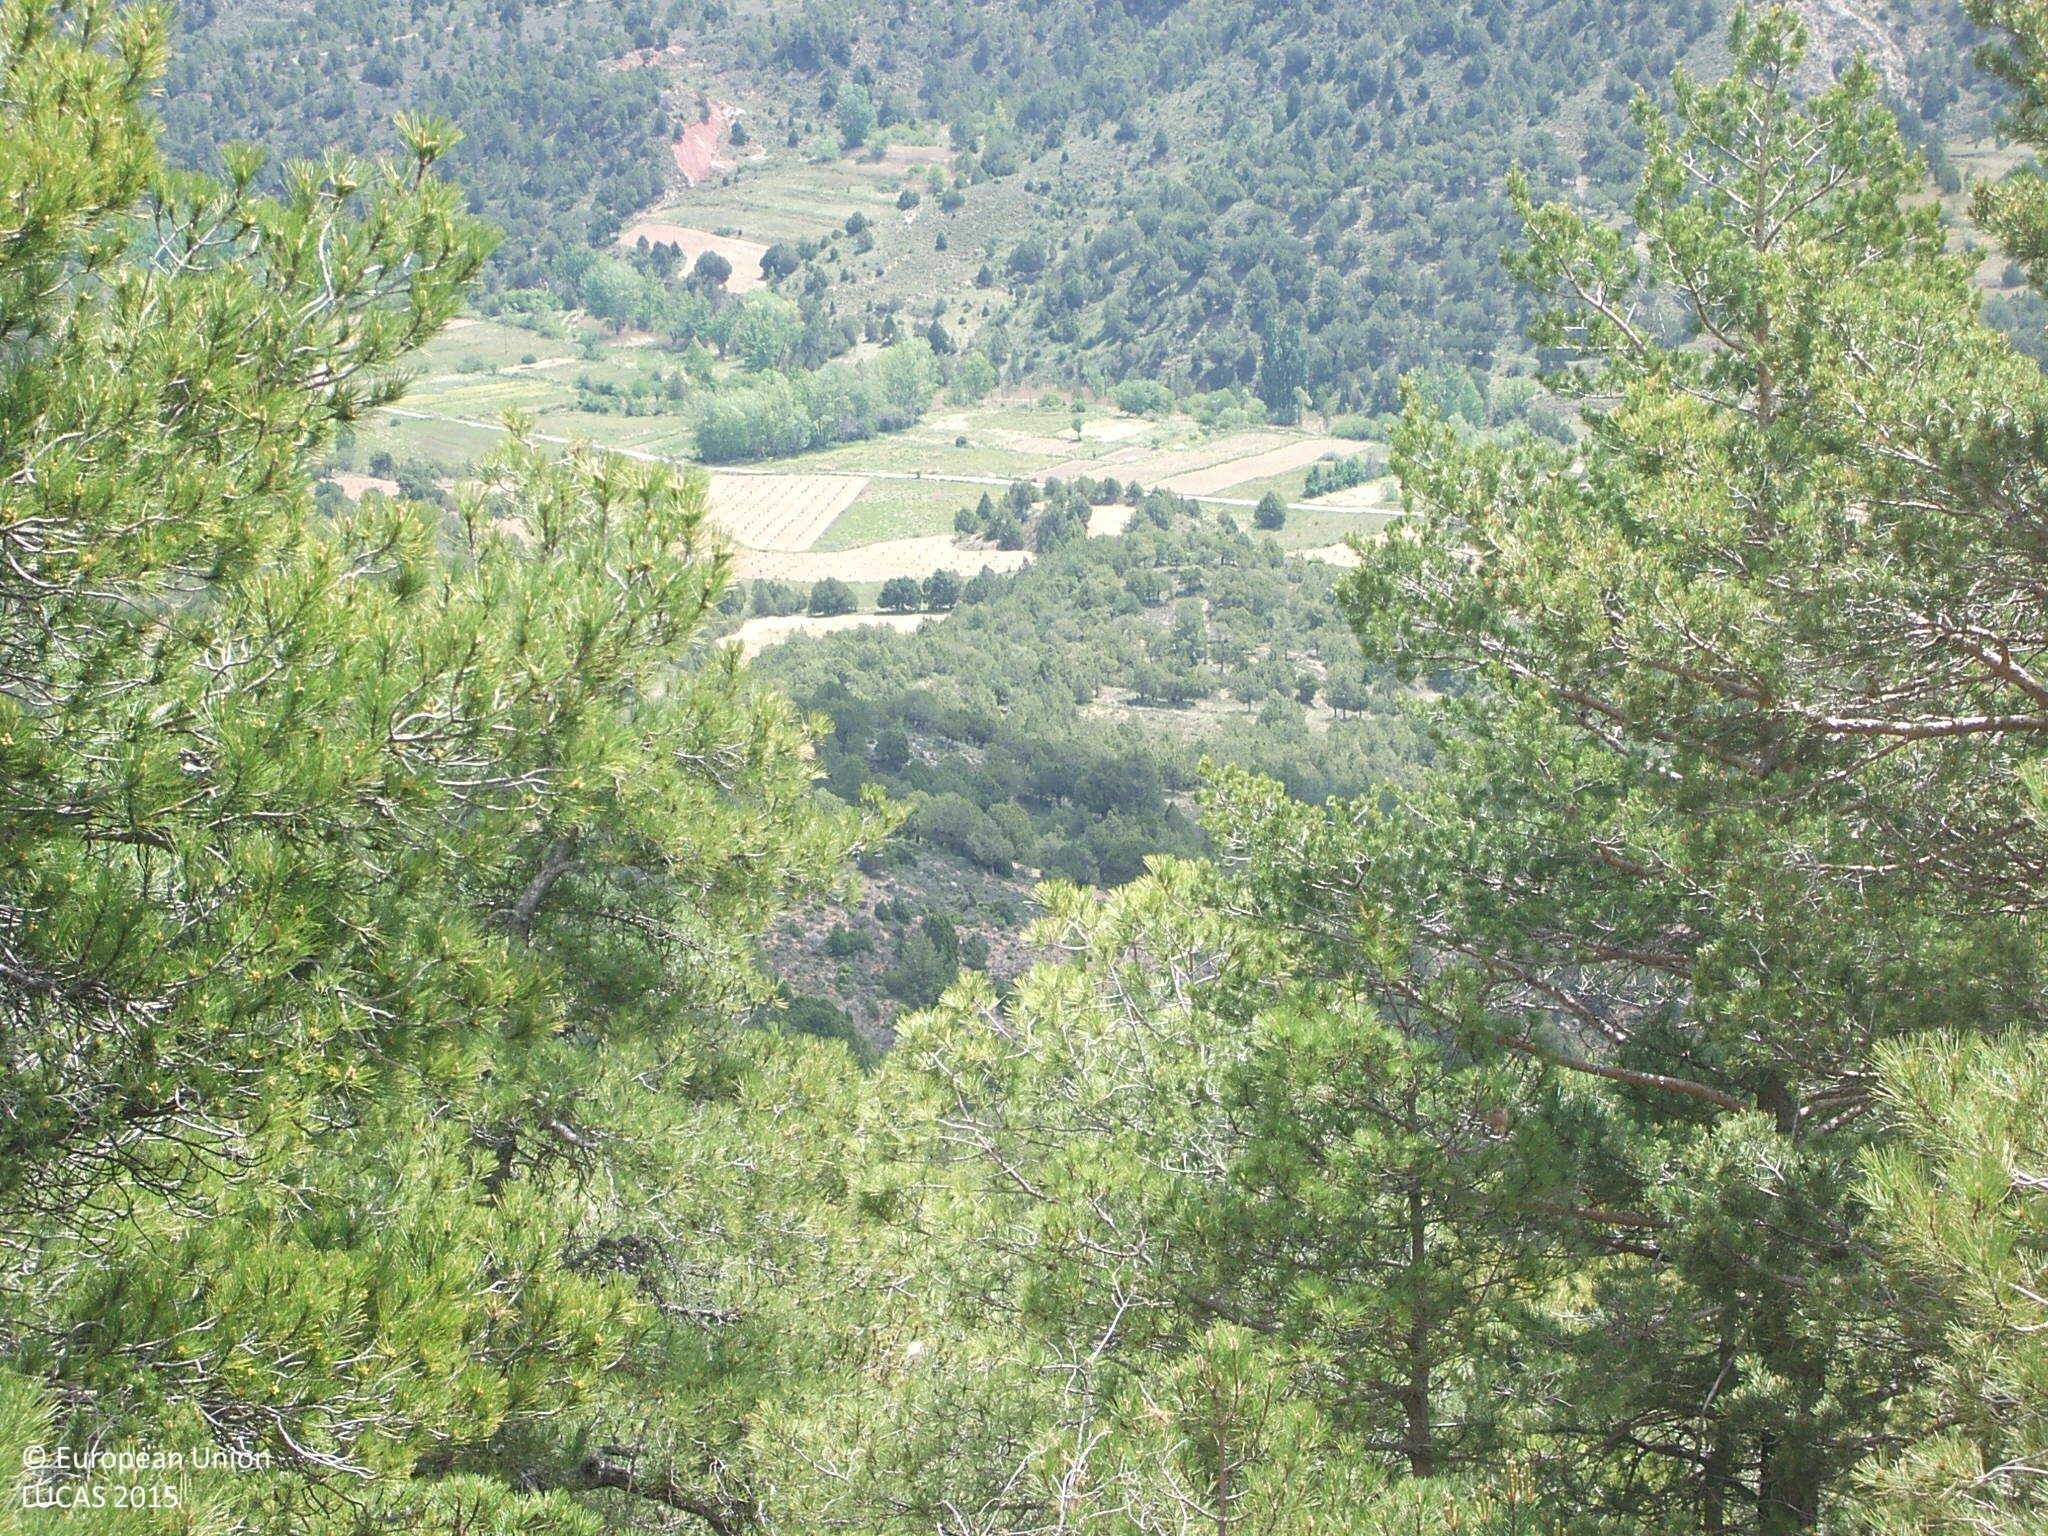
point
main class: Woodland
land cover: Pine dominated coniferous woodland
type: coniferous forest of the mediterranean region
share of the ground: 25 - 50 %
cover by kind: consolidated bare surface 50 %, coniferous forest trees 40 %, shrubs 10 %
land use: Semi-natural and natural areas not in use
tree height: > 5 m
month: May
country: ES
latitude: 40.0546
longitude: -0.9437
